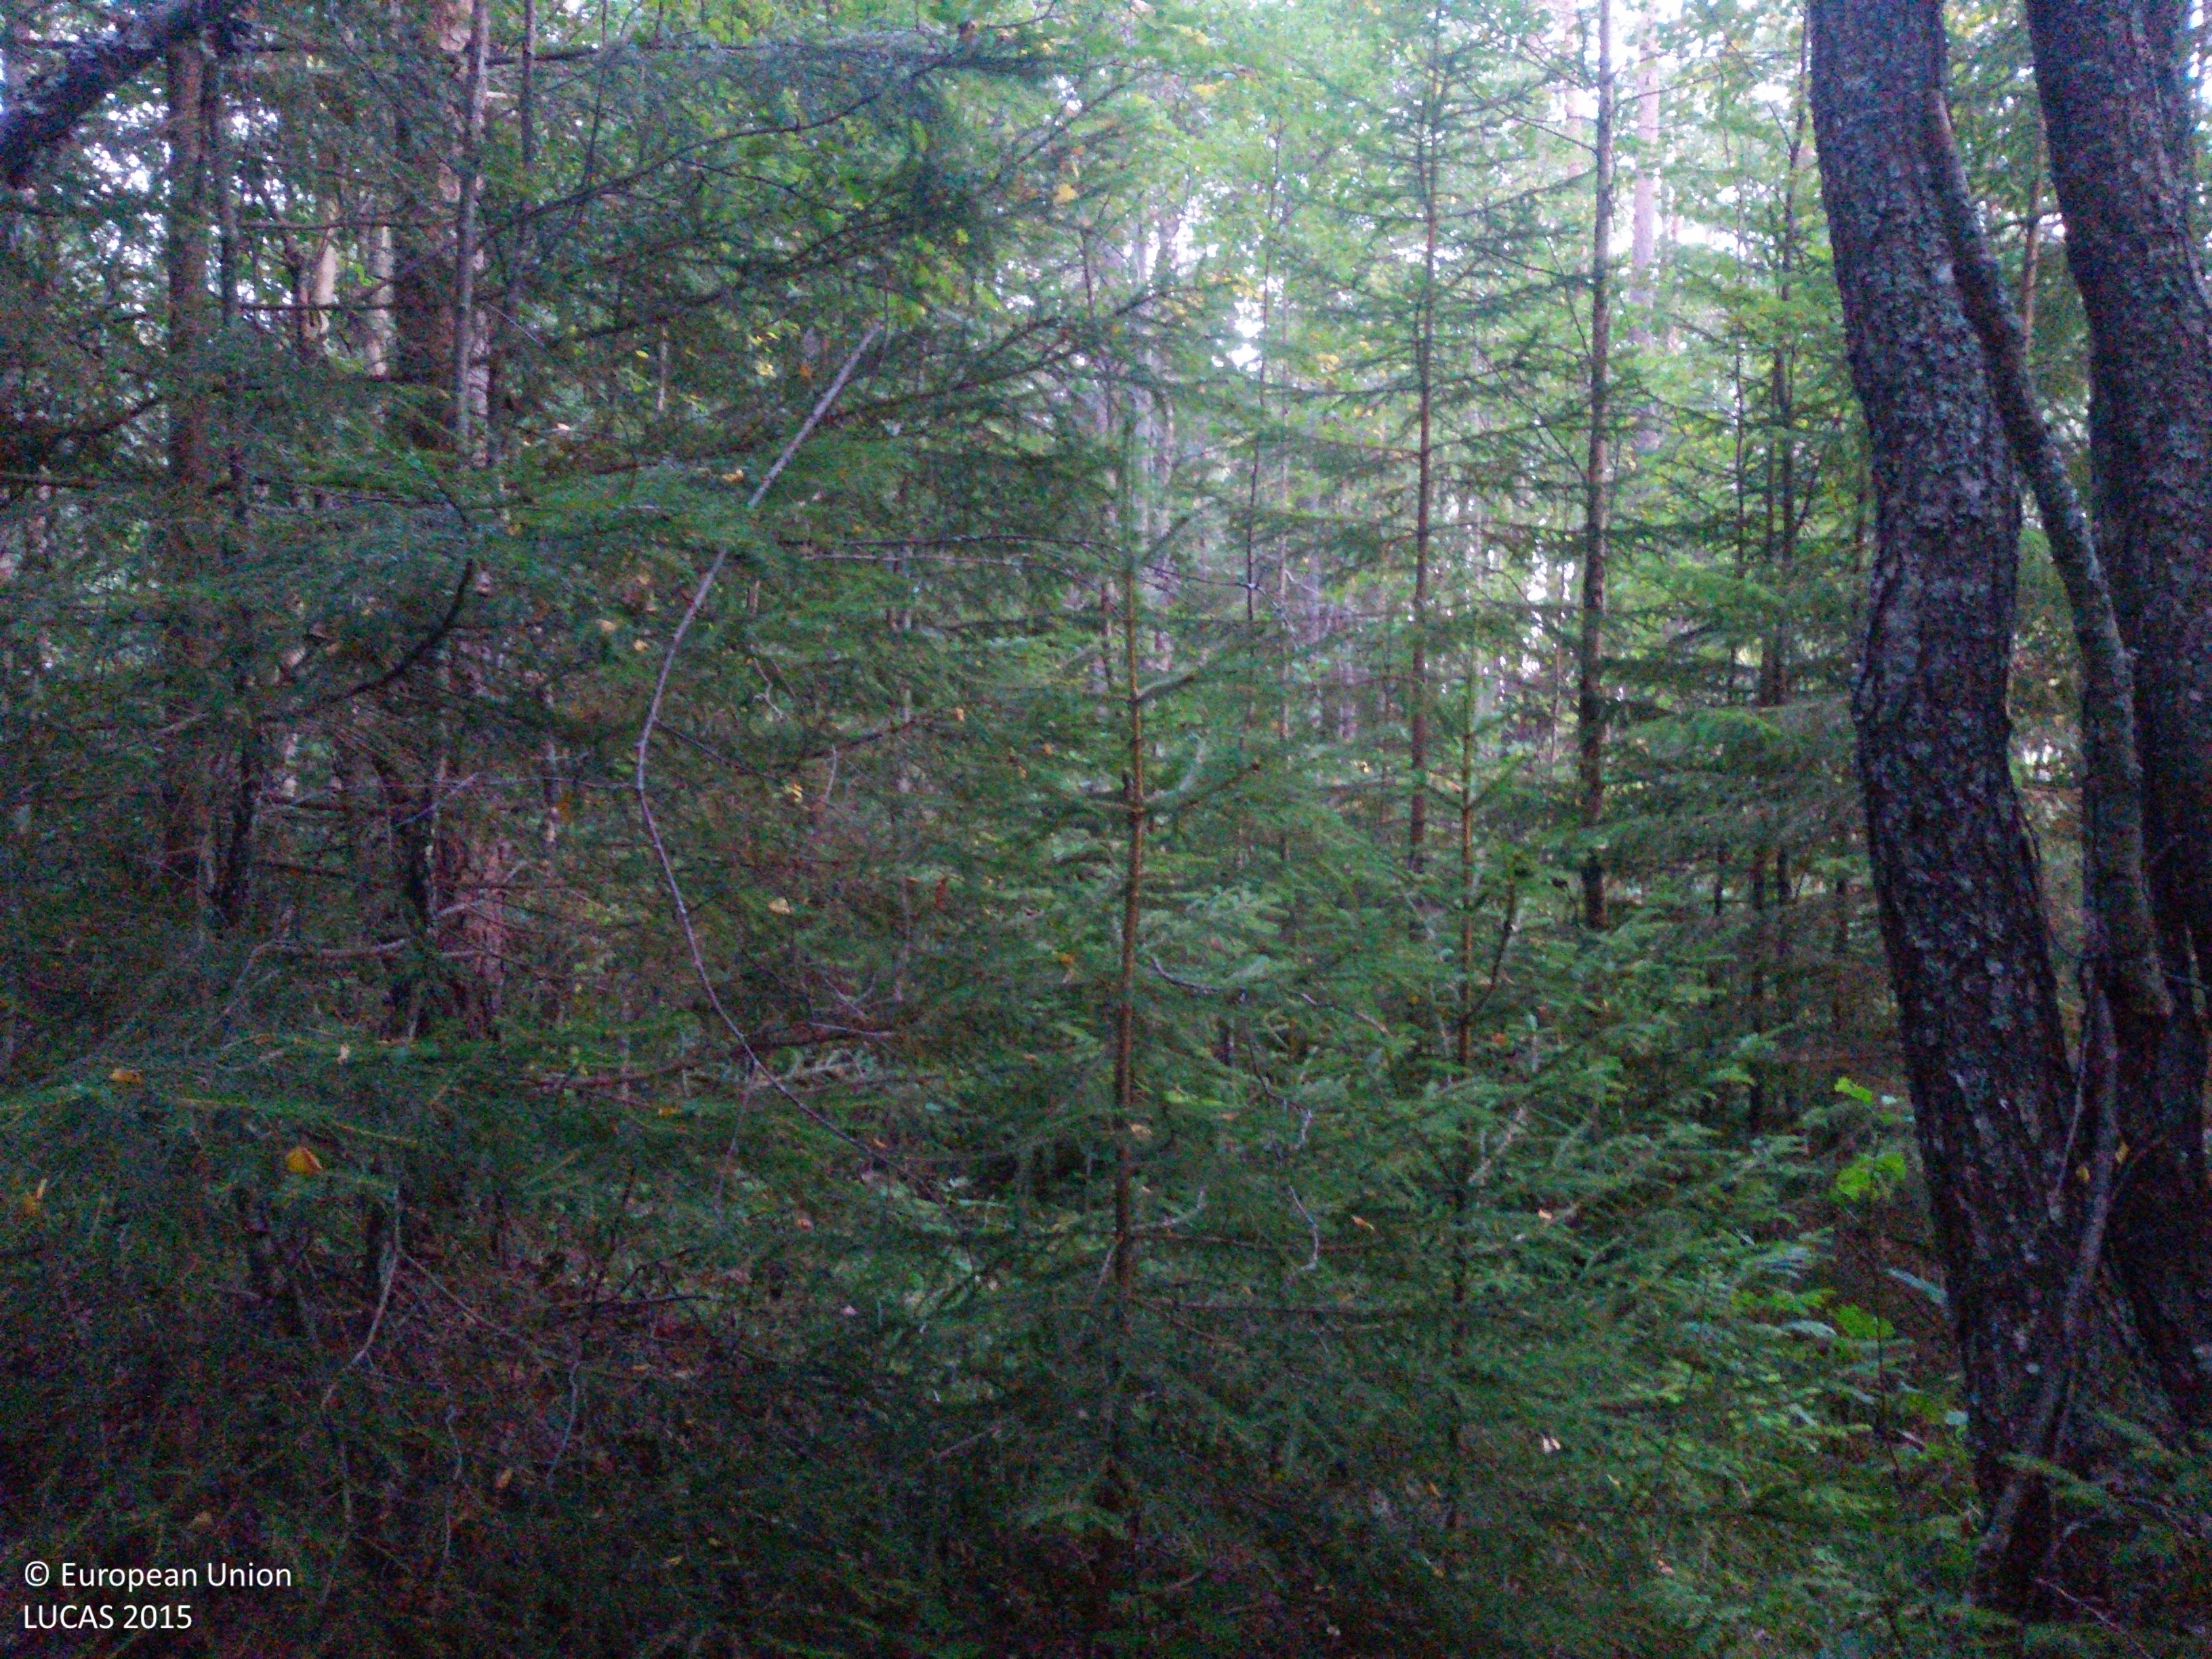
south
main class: Woodland
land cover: Pine dominated mixed woodland
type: boreal forest
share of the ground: > 75 %
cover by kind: coniferous forest trees 40 %, broadleaved forest trees 40 %, herbaceous plants 15 %, lichens and mosses 5 %
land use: Forestry
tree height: > 5 m
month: September
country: SE
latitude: 60.8880
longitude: 14.9432
